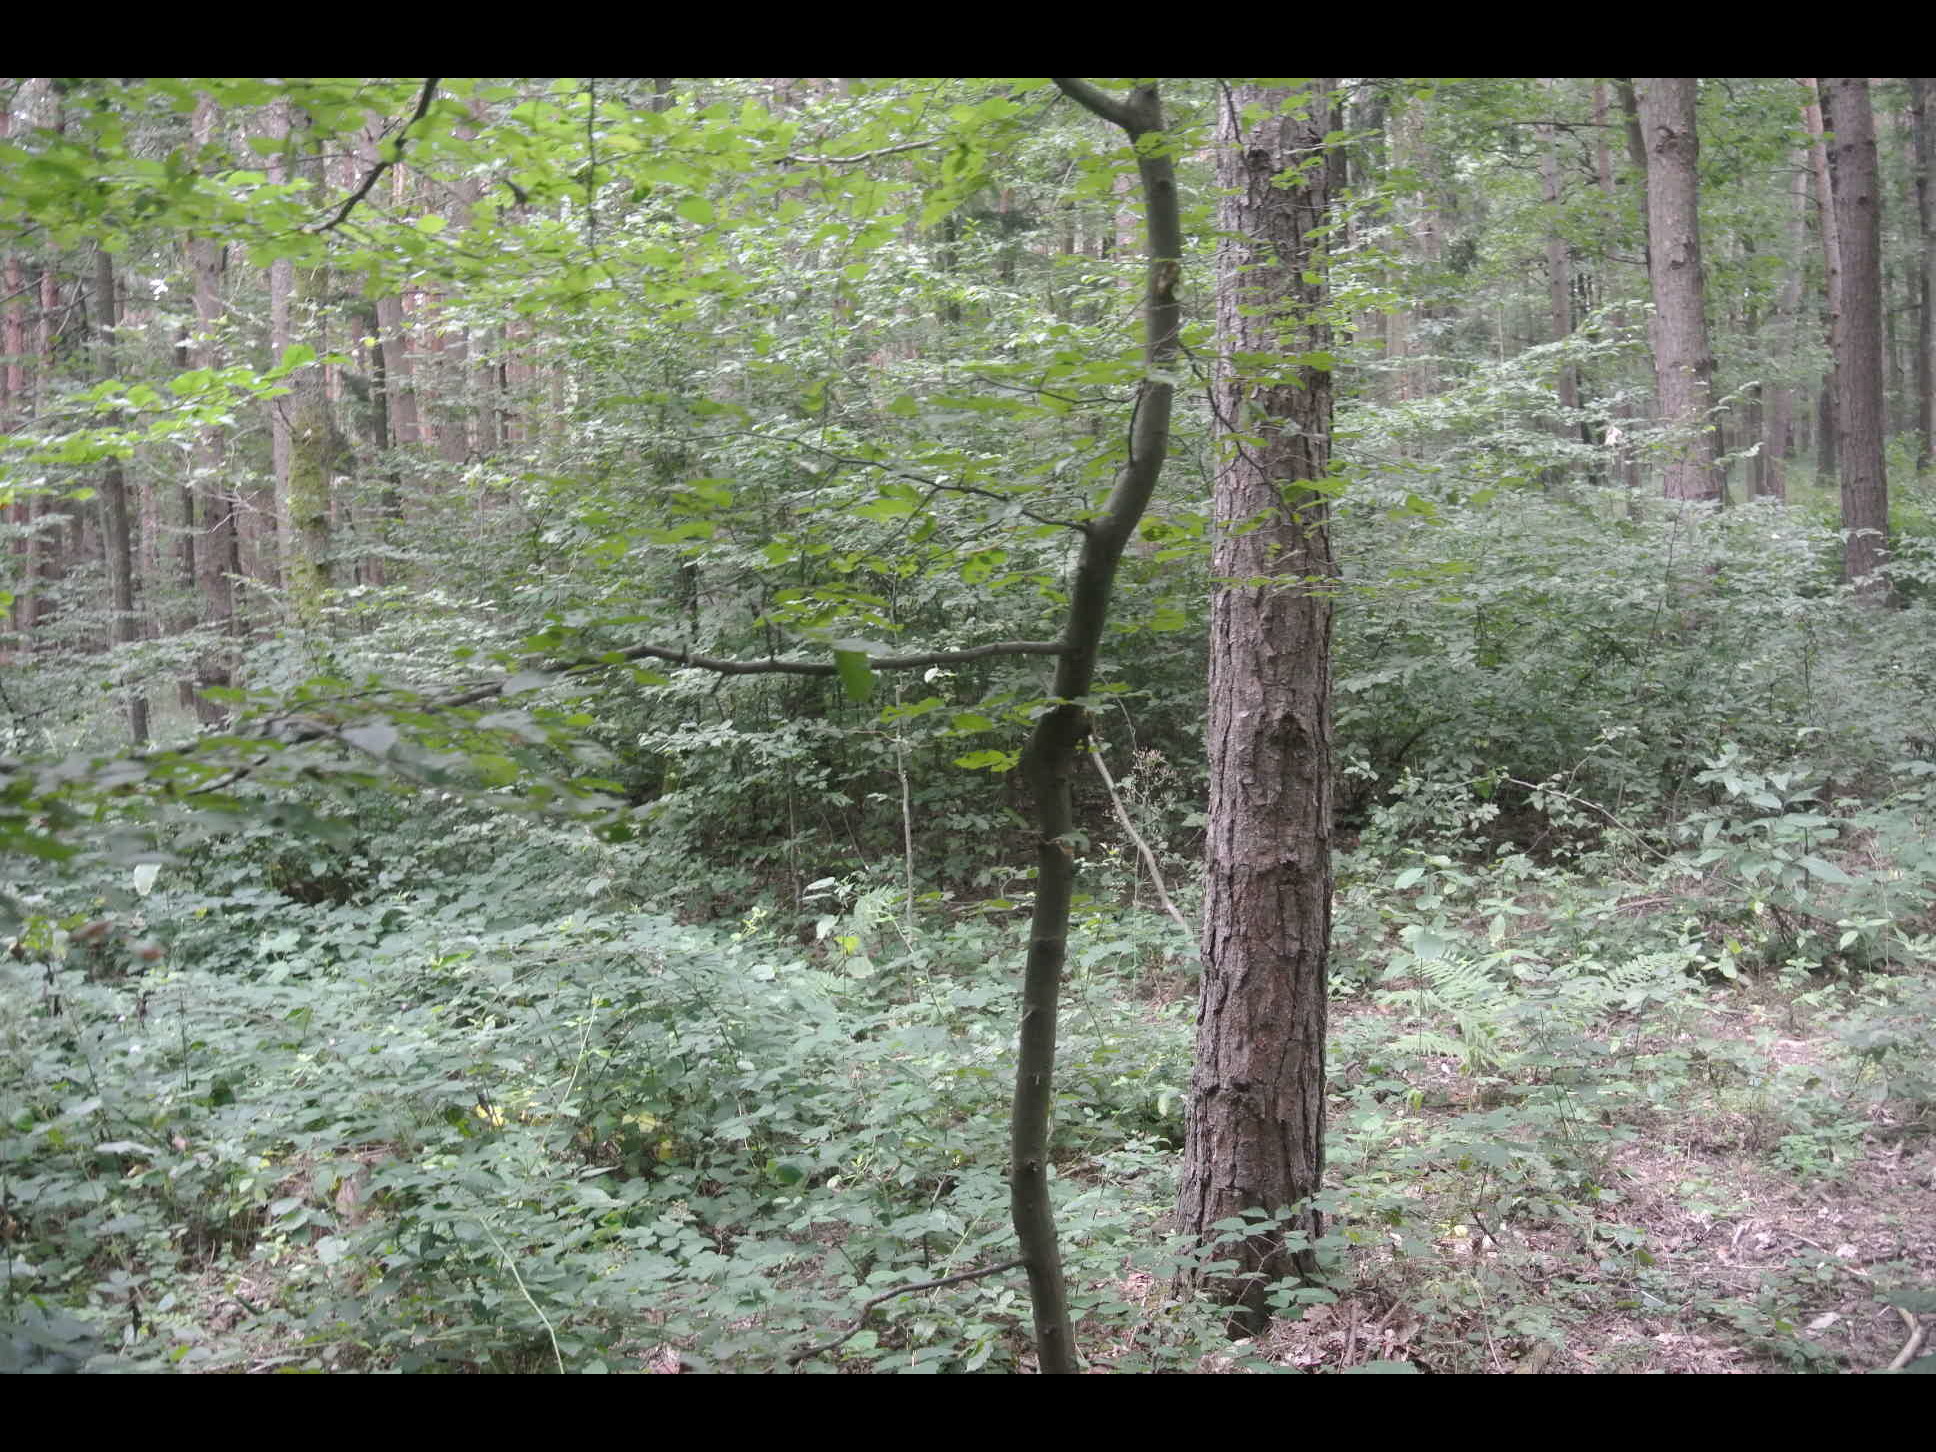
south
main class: Woodland
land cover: Pine dominated mixed woodland
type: alpine coniferous forest
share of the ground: > 75 %
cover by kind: coniferous forest trees 60 %, broadleaved forest trees 40 %
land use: Forestry
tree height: > 5 m
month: July
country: AT
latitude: 47.5115
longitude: 16.4435
